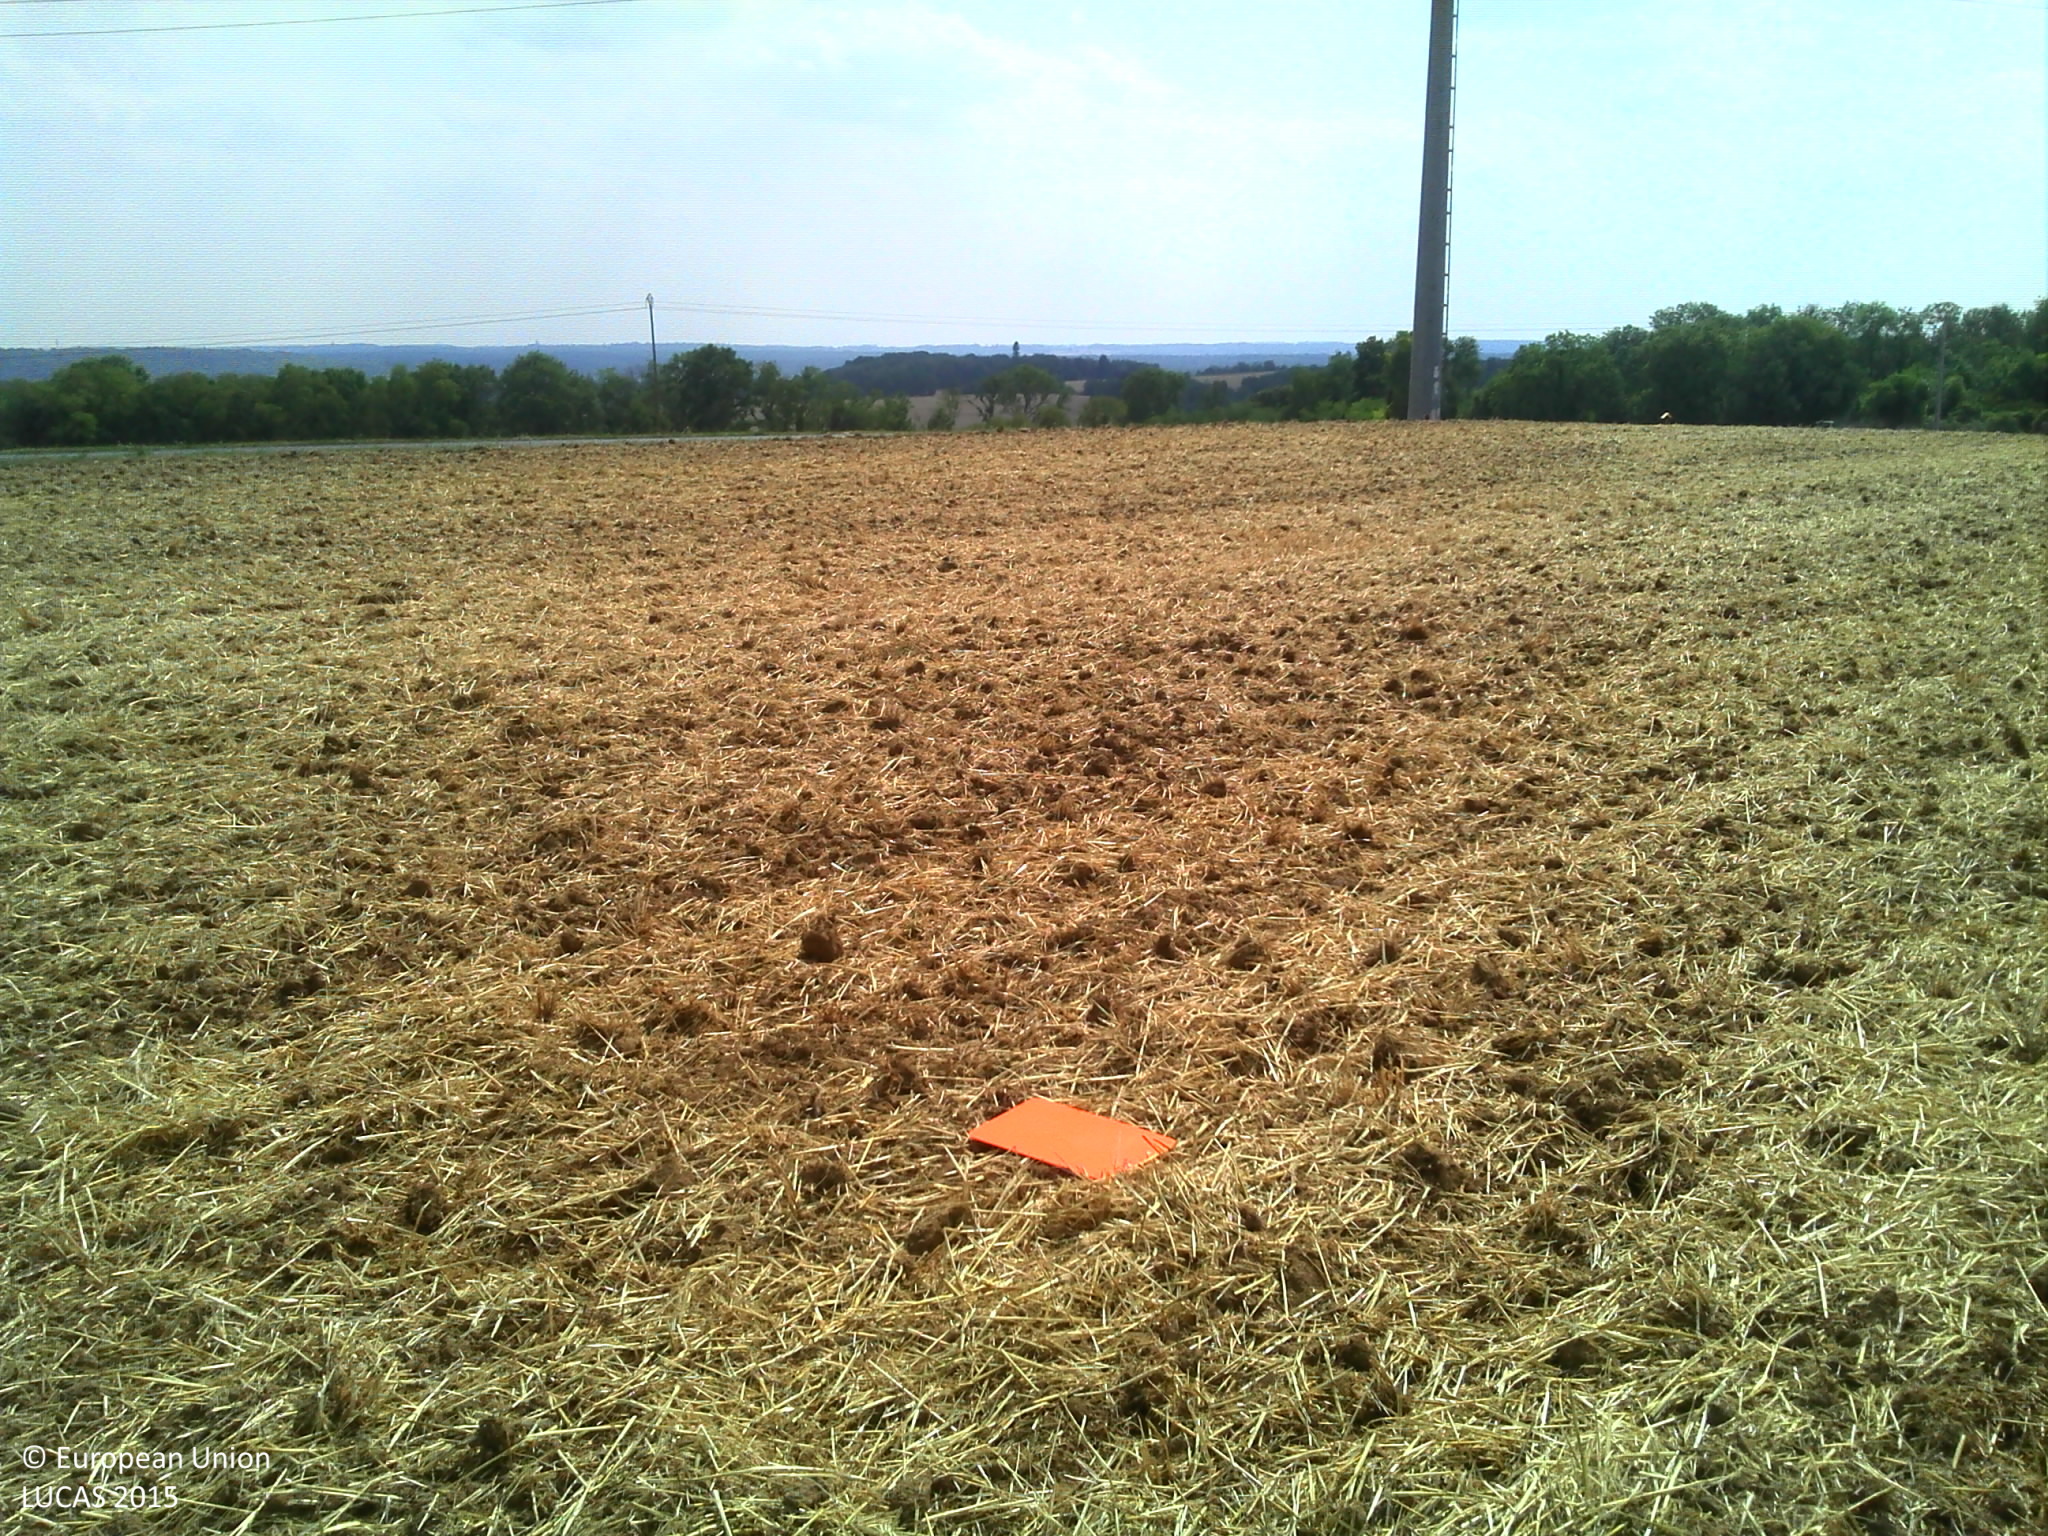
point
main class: Cropland
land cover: Common wheat
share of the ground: > 75 %
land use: Agriculture (excluding fallow land and kitchen gardens)
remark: Harvested field
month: August
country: FR
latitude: 49.0287
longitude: 2.9748
